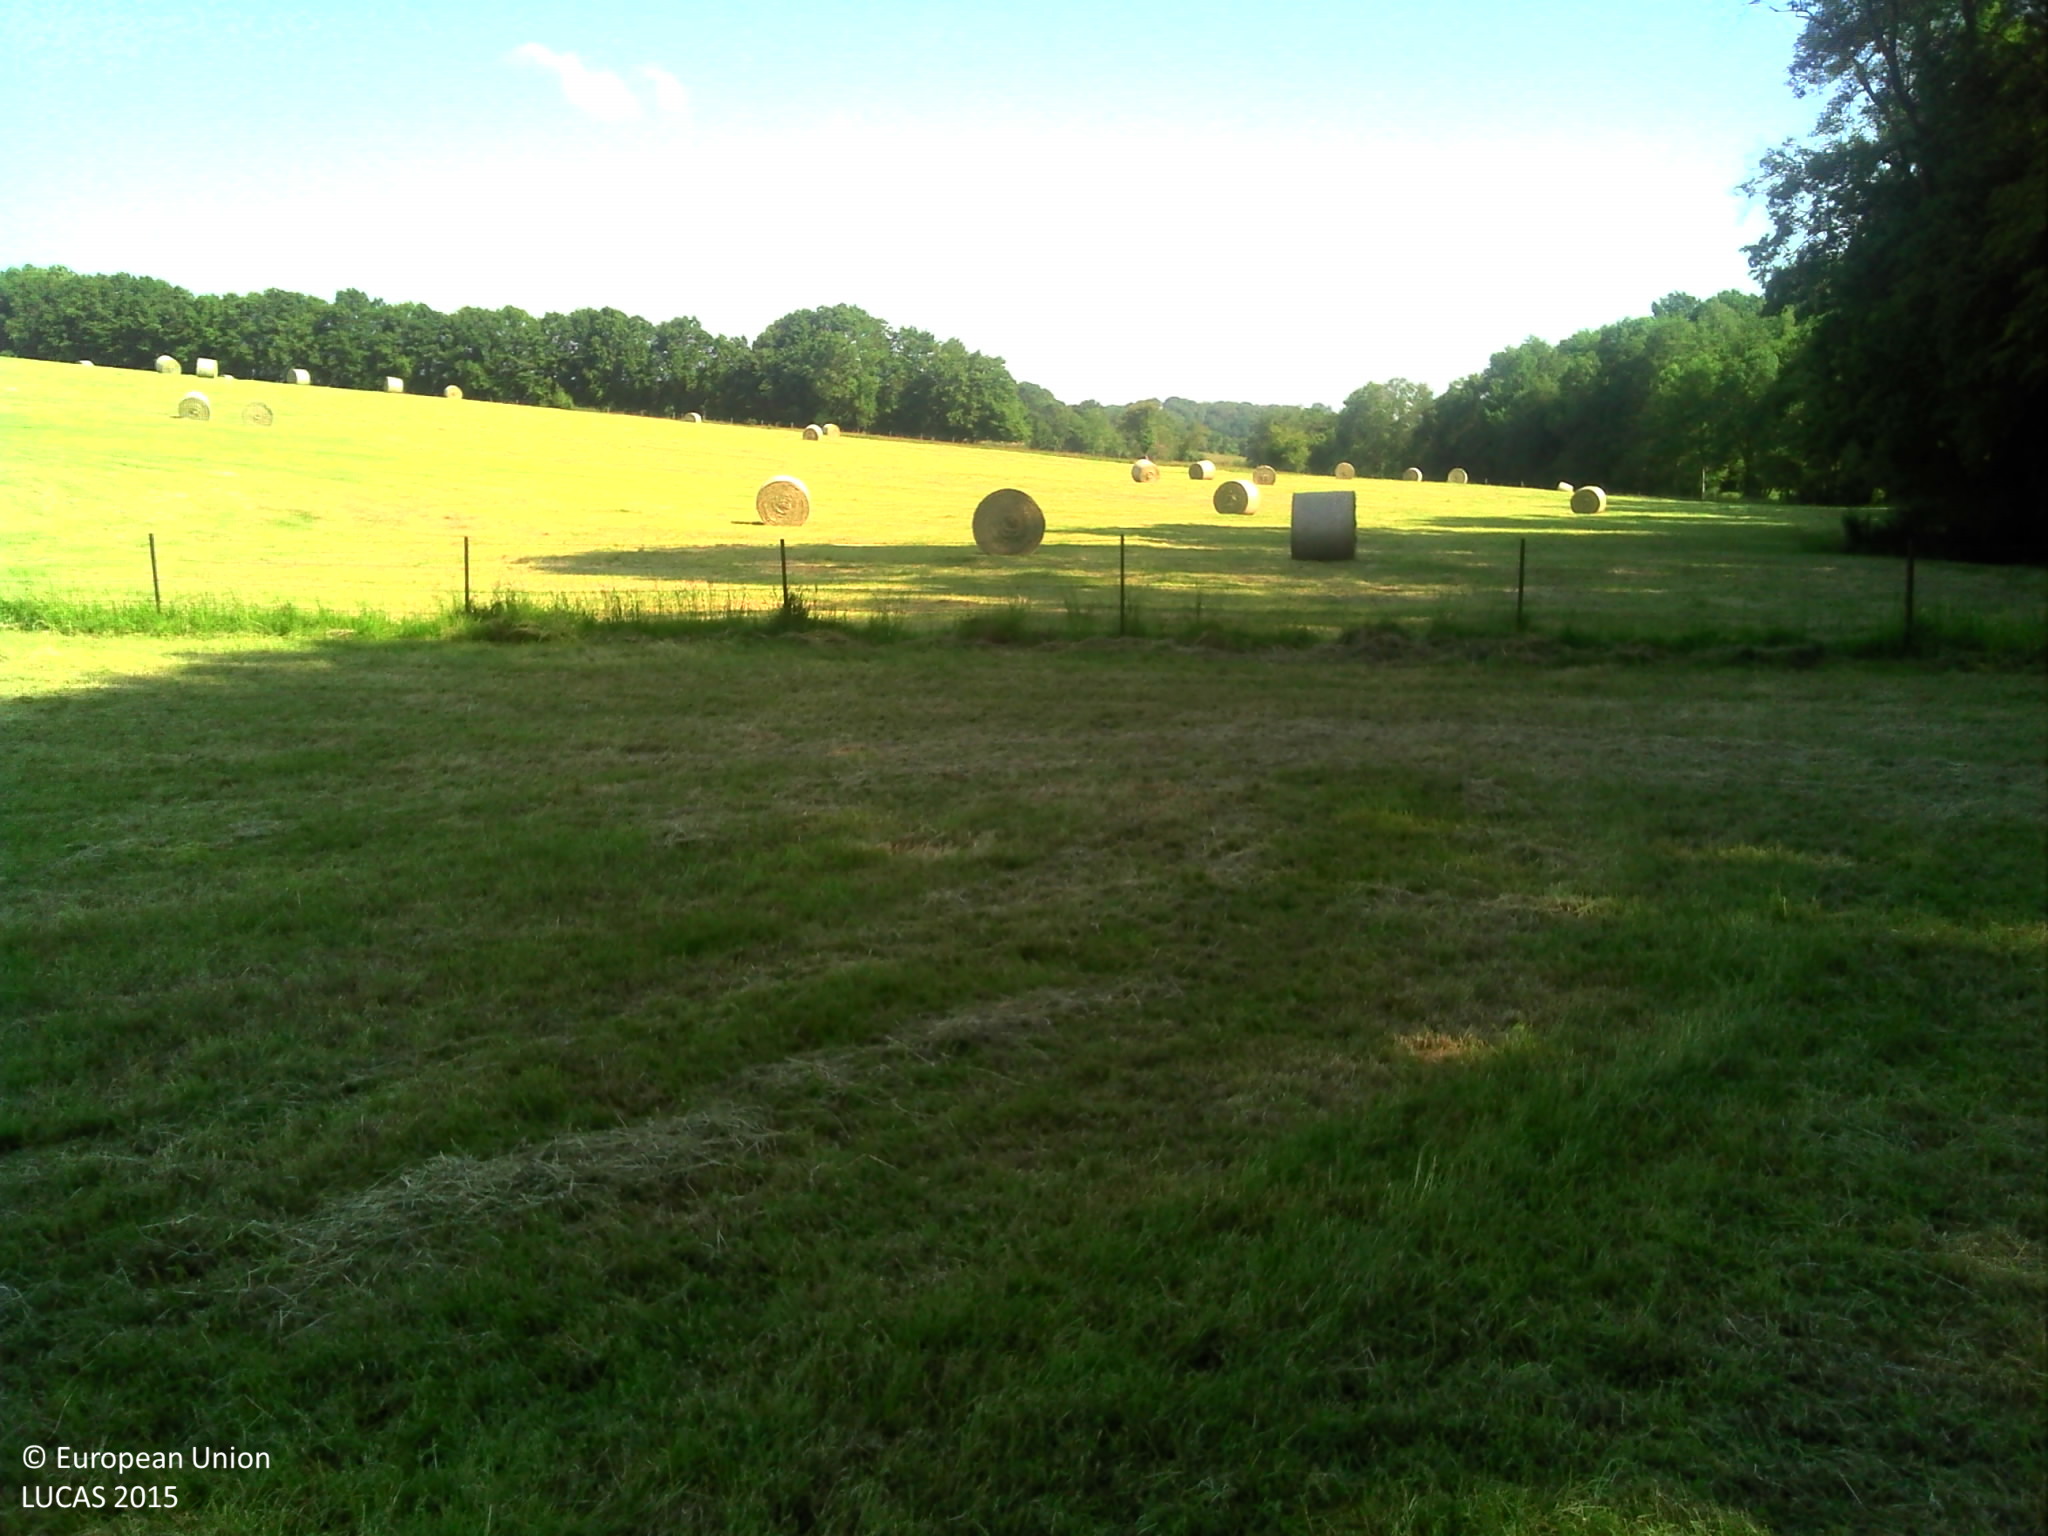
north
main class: Grassland
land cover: Grassland without tree/shrub cover
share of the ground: > 75 %
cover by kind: herbaceous plants 100 %
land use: Agriculture (excluding fallow land and kitchen gardens)
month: June
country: FR
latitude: 49.8668
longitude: 4.0540
